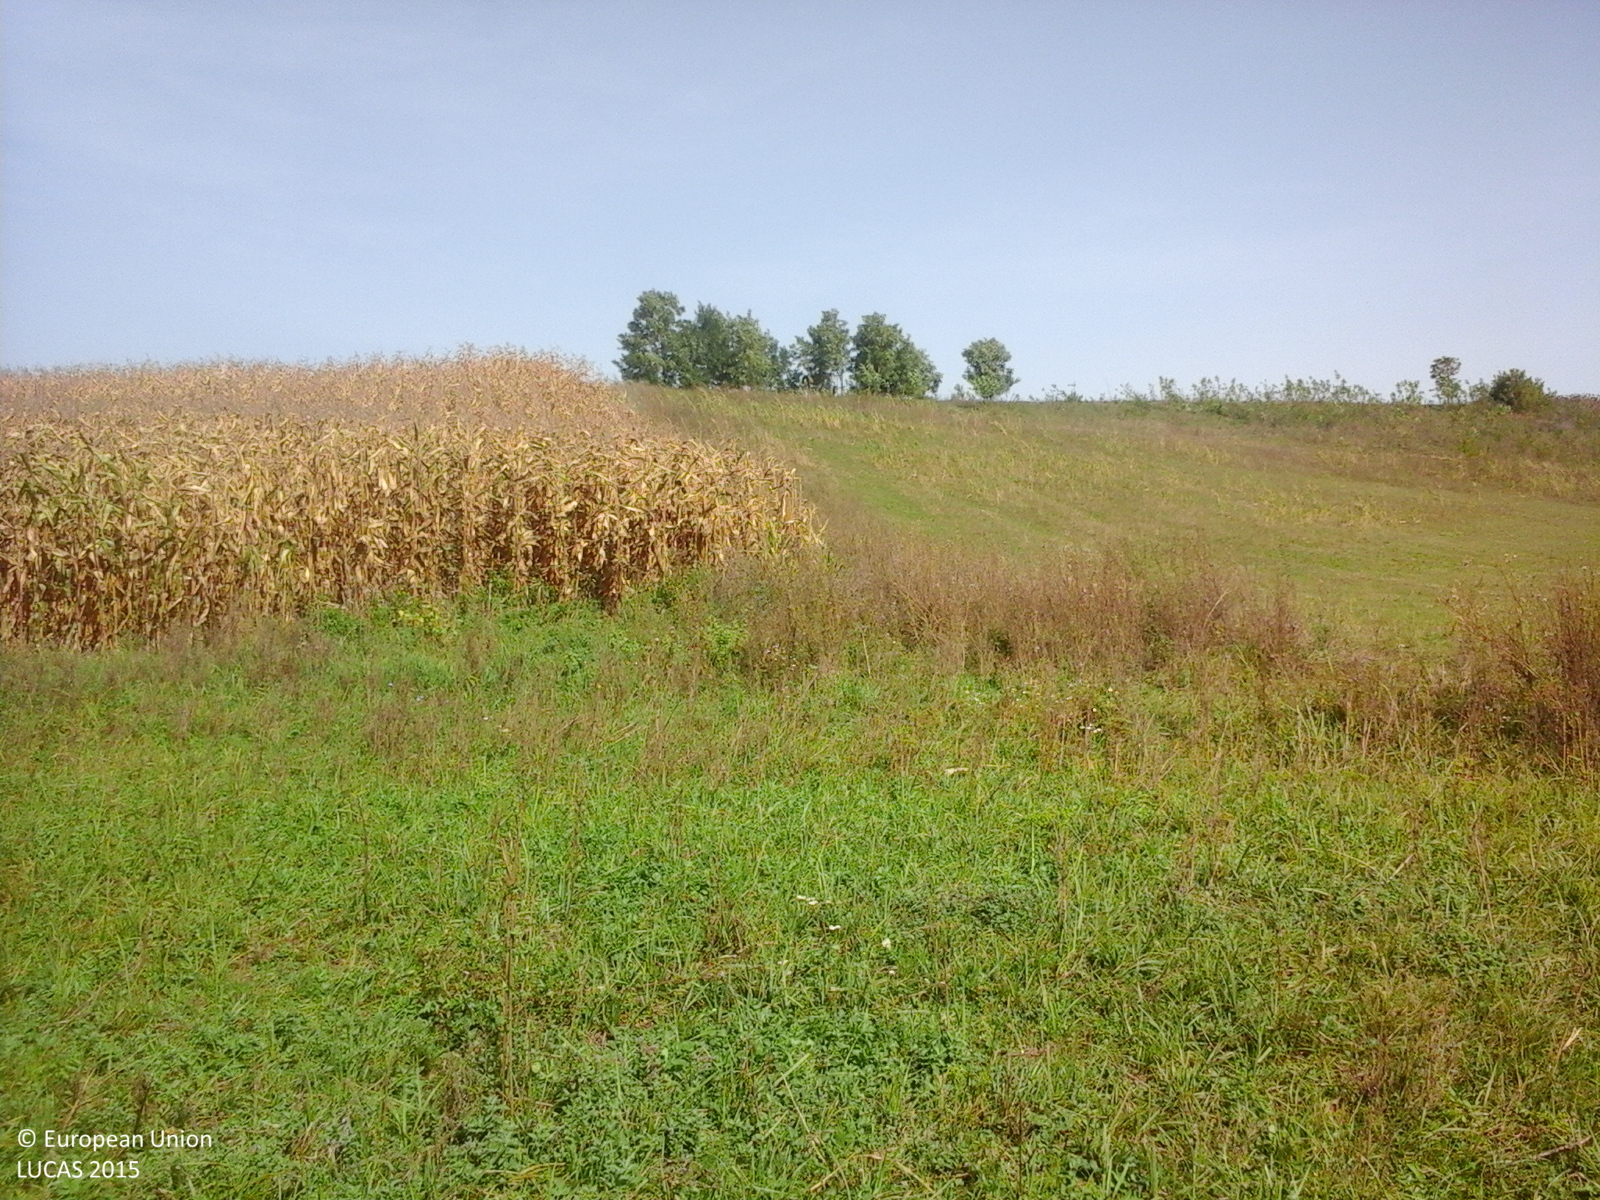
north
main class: Grassland
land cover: Grassland without tree/shrub cover
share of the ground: > 75 %
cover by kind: herbaceous plants 100 %
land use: Agriculture (excluding fallow land and kitchen gardens)
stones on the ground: < 10 %
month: September
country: RO
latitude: 46.7176
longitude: 24.1715
